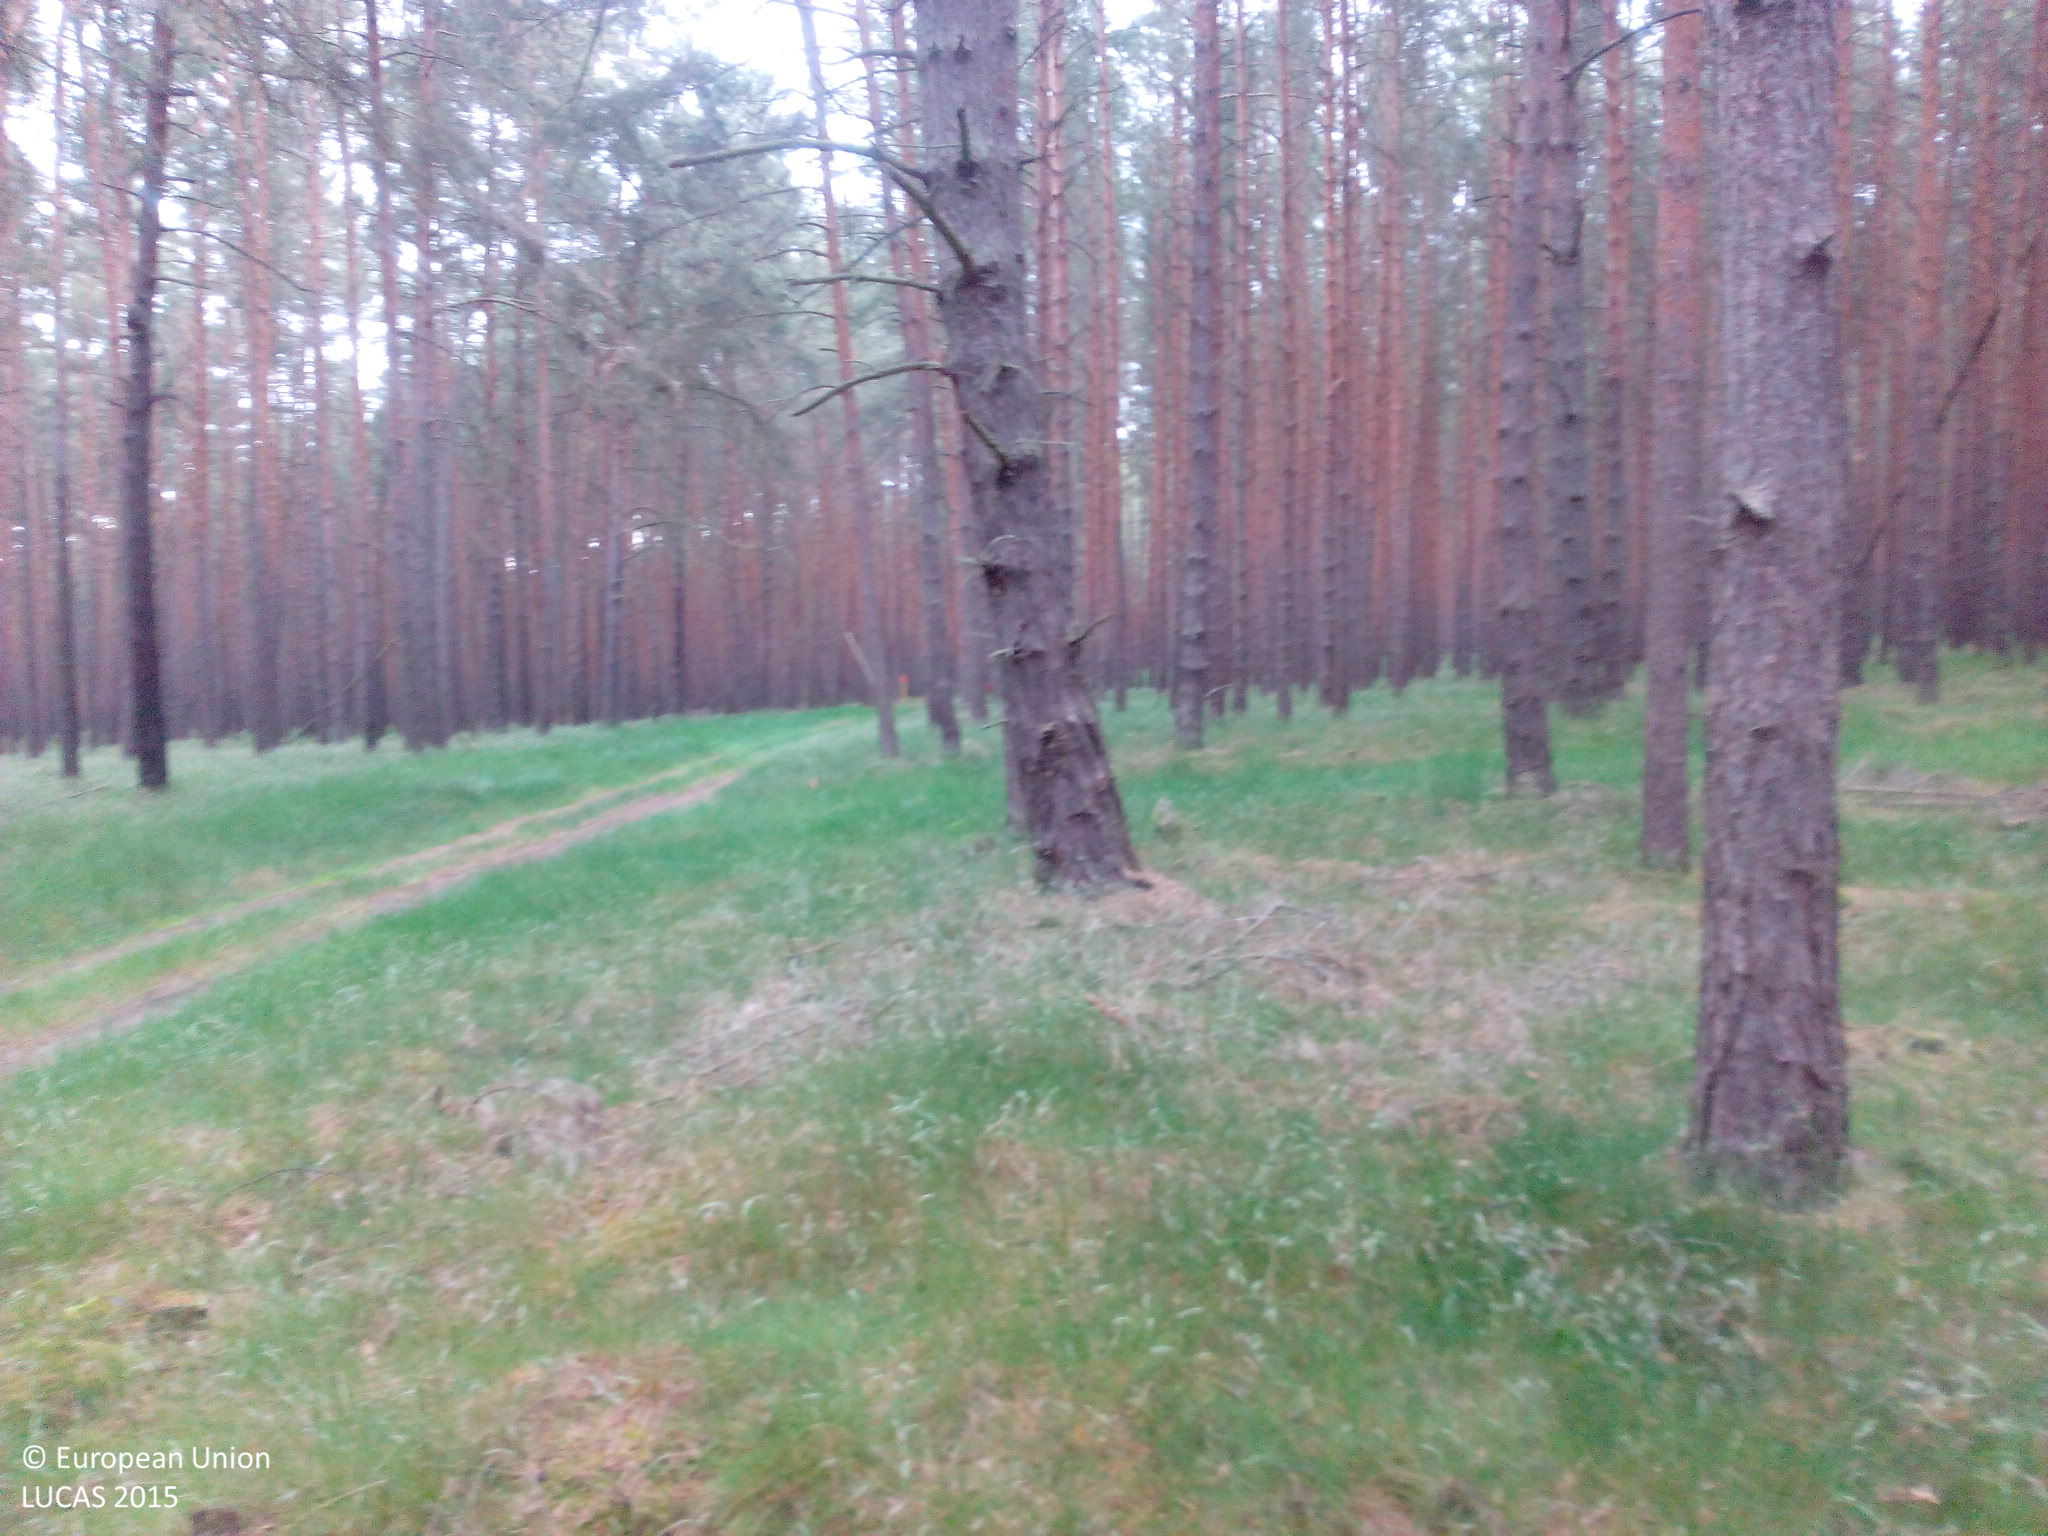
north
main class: Woodland
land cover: Pine dominated coniferous woodland
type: hemiboreal forest and nemoral coniferous forest and mixed broadleaved-coniferous forest
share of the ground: > 75 %
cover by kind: coniferous forest trees 90 %, herbaceous plants 5 %, lichens and mosses 5 %
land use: Forestry
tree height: > 5 m
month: June
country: DE
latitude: 52.3132
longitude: 12.5960
